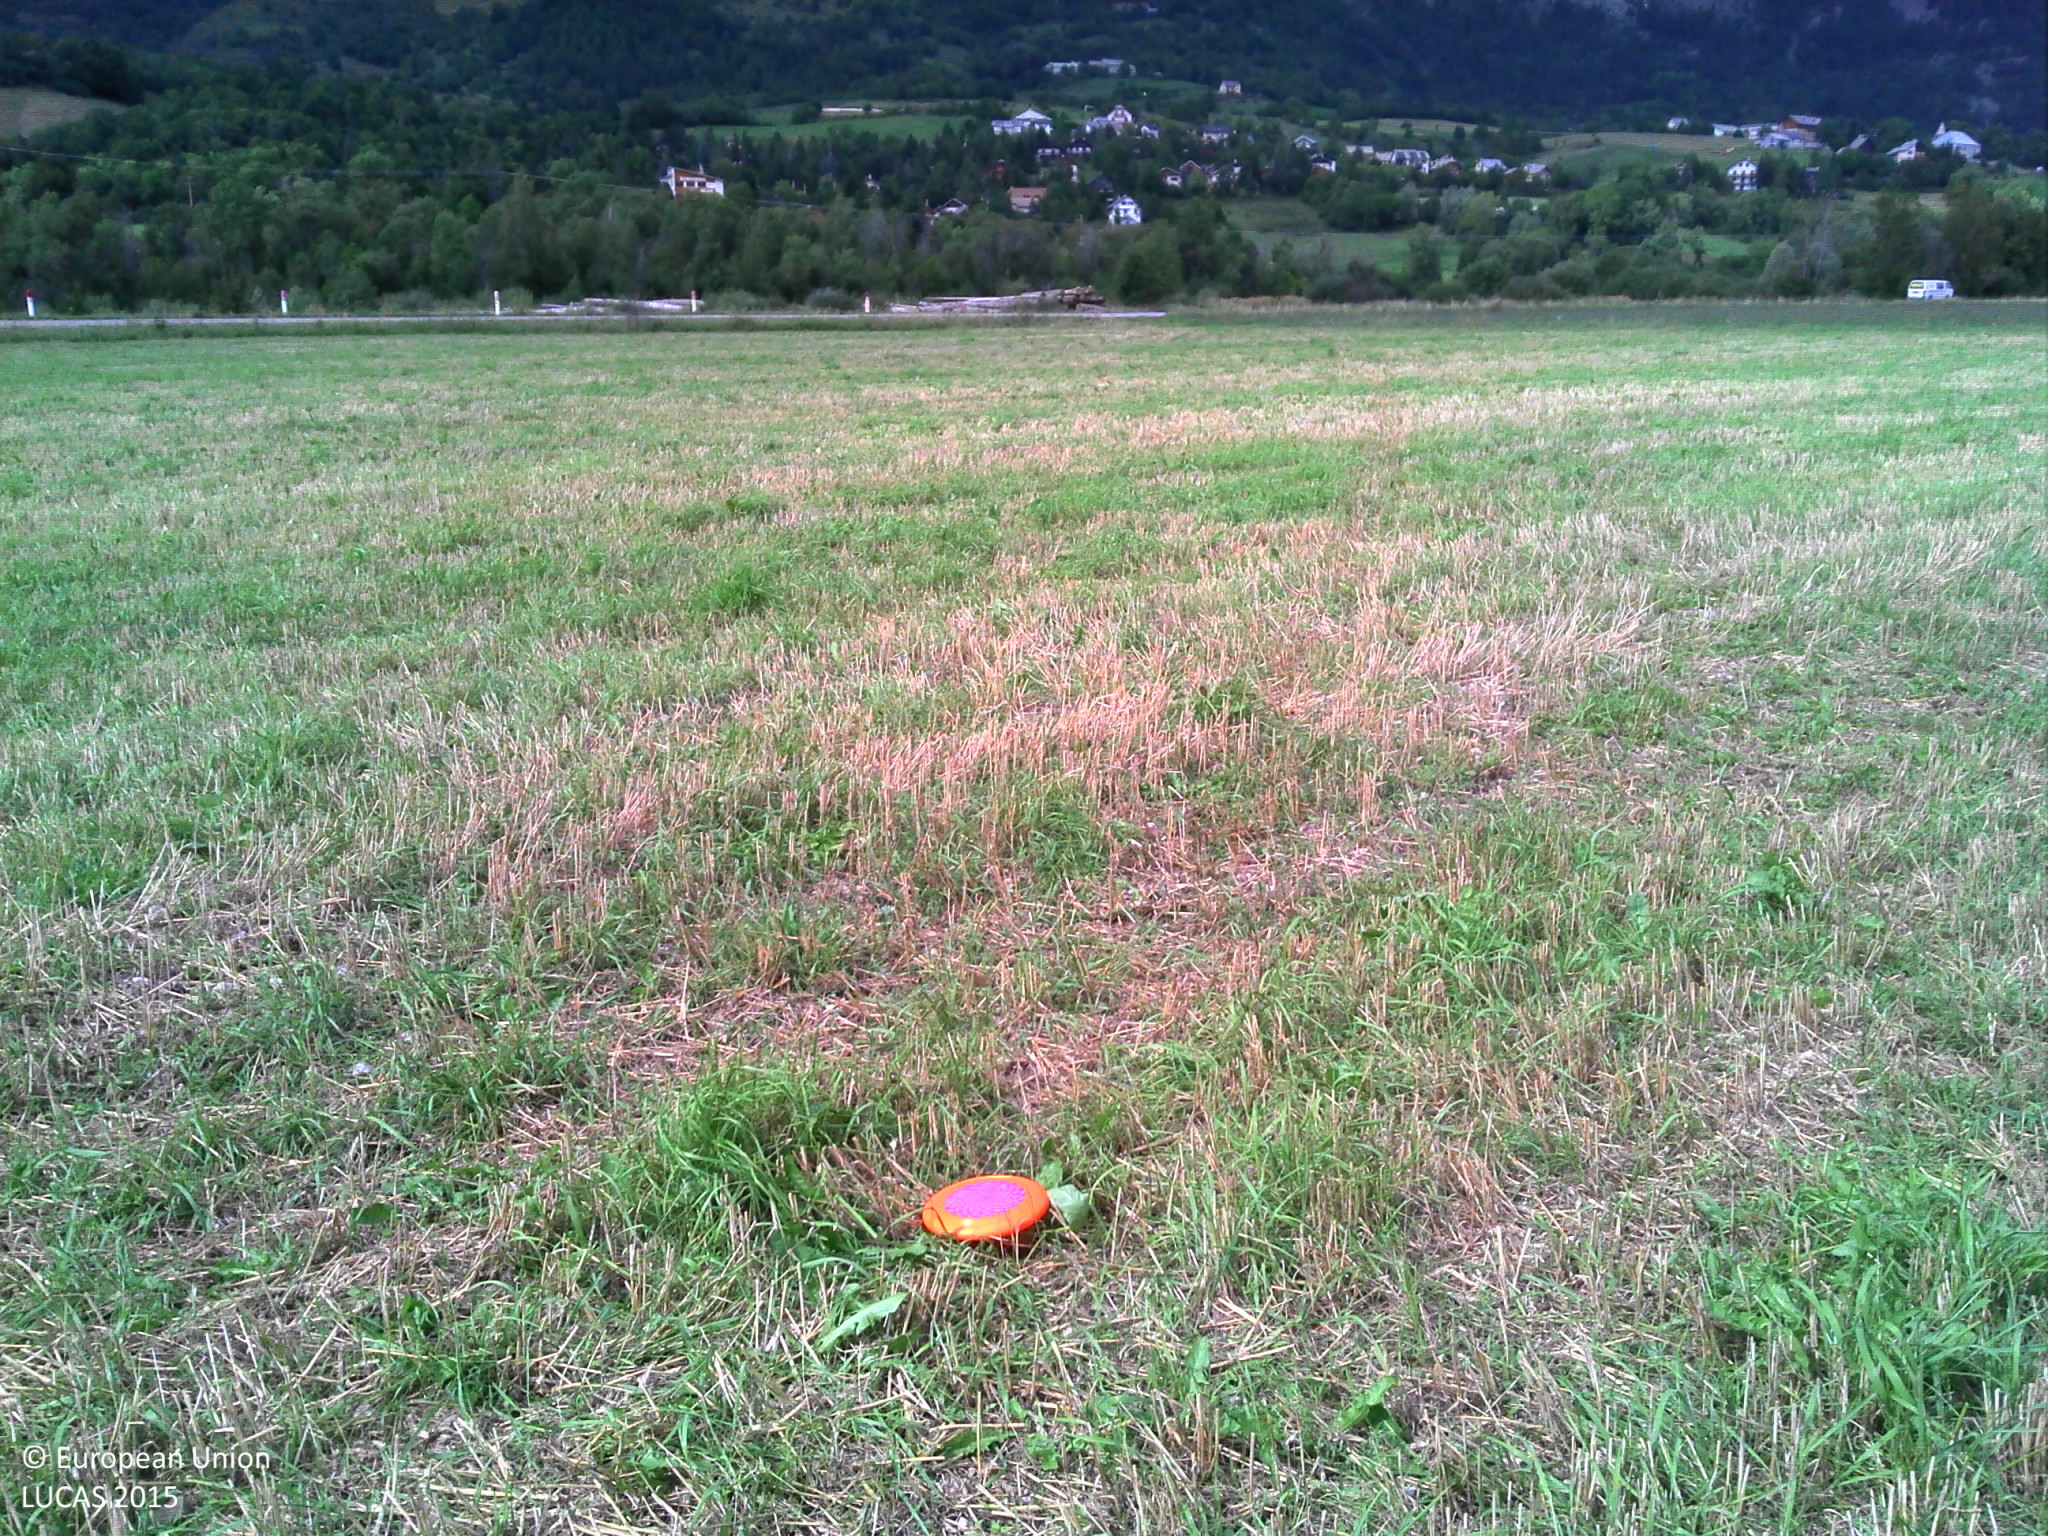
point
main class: Cropland
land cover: Common wheat
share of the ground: > 75 %
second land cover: Spontaneously vegetated surfaces
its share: > 75 %
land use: Agriculture (excluding fallow land and kitchen gardens)
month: September
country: FR
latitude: 44.6605
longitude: 6.2102
